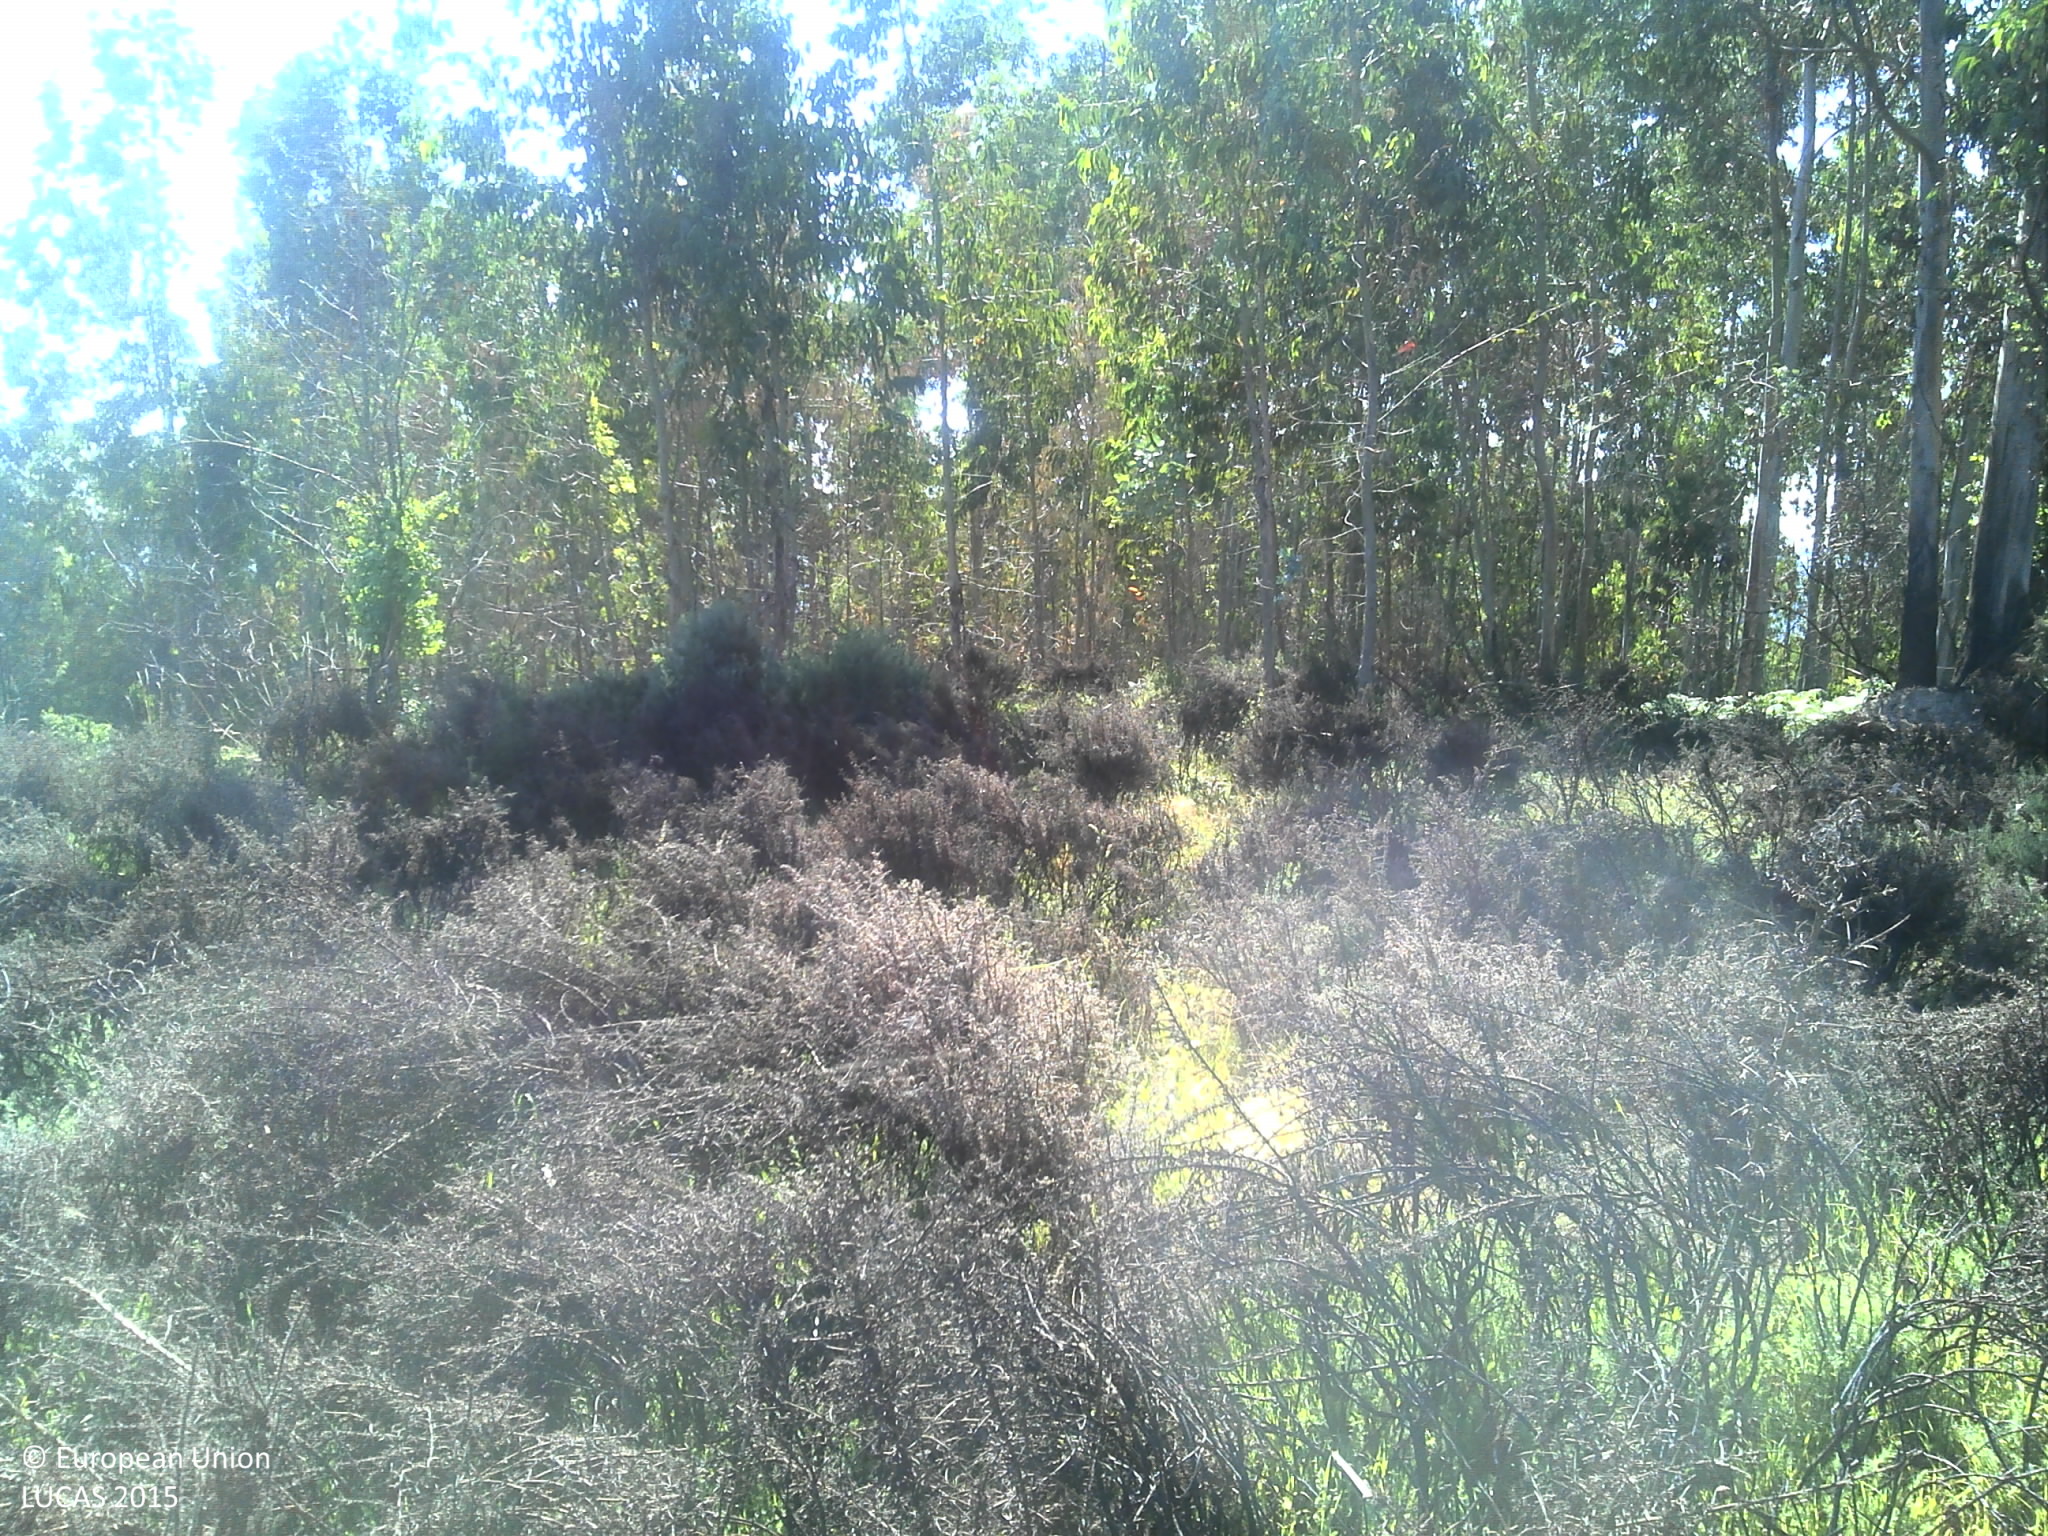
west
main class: Shrubland
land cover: Shrubland without tree cover
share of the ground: > 75 %
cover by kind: shrubs 85 %, herbaceous plants 10 %, unconsolidated bare surface 5 %
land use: Agriculture (excluding fallow land and kitchen gardens)
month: June
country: PT
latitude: 41.4836
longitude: -8.2192
